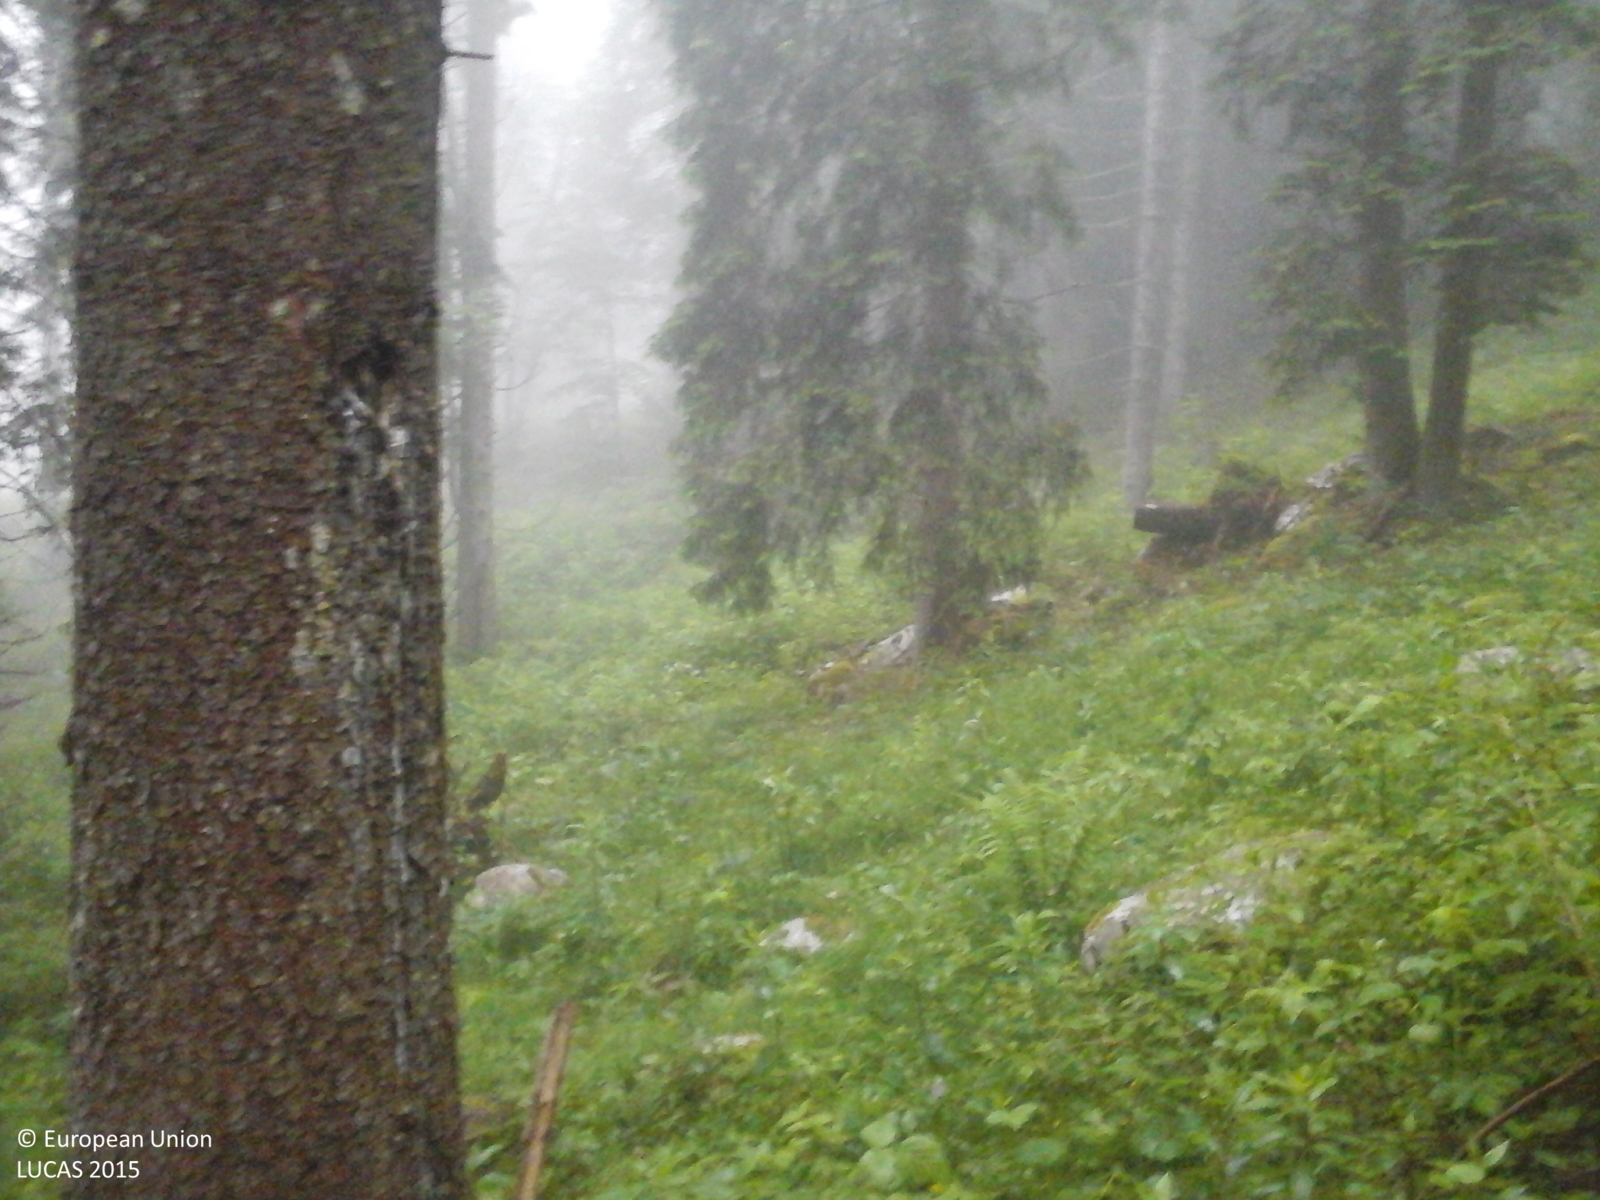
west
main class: Woodland
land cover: Spruce dominated coniferous woodland
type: alpine coniferous forest
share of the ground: > 75 %
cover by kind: coniferous forest trees 100 %
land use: Forestry
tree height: > 5 m
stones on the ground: 10 - 25 %
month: June
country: IT
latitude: 45.9254
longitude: 11.5581
